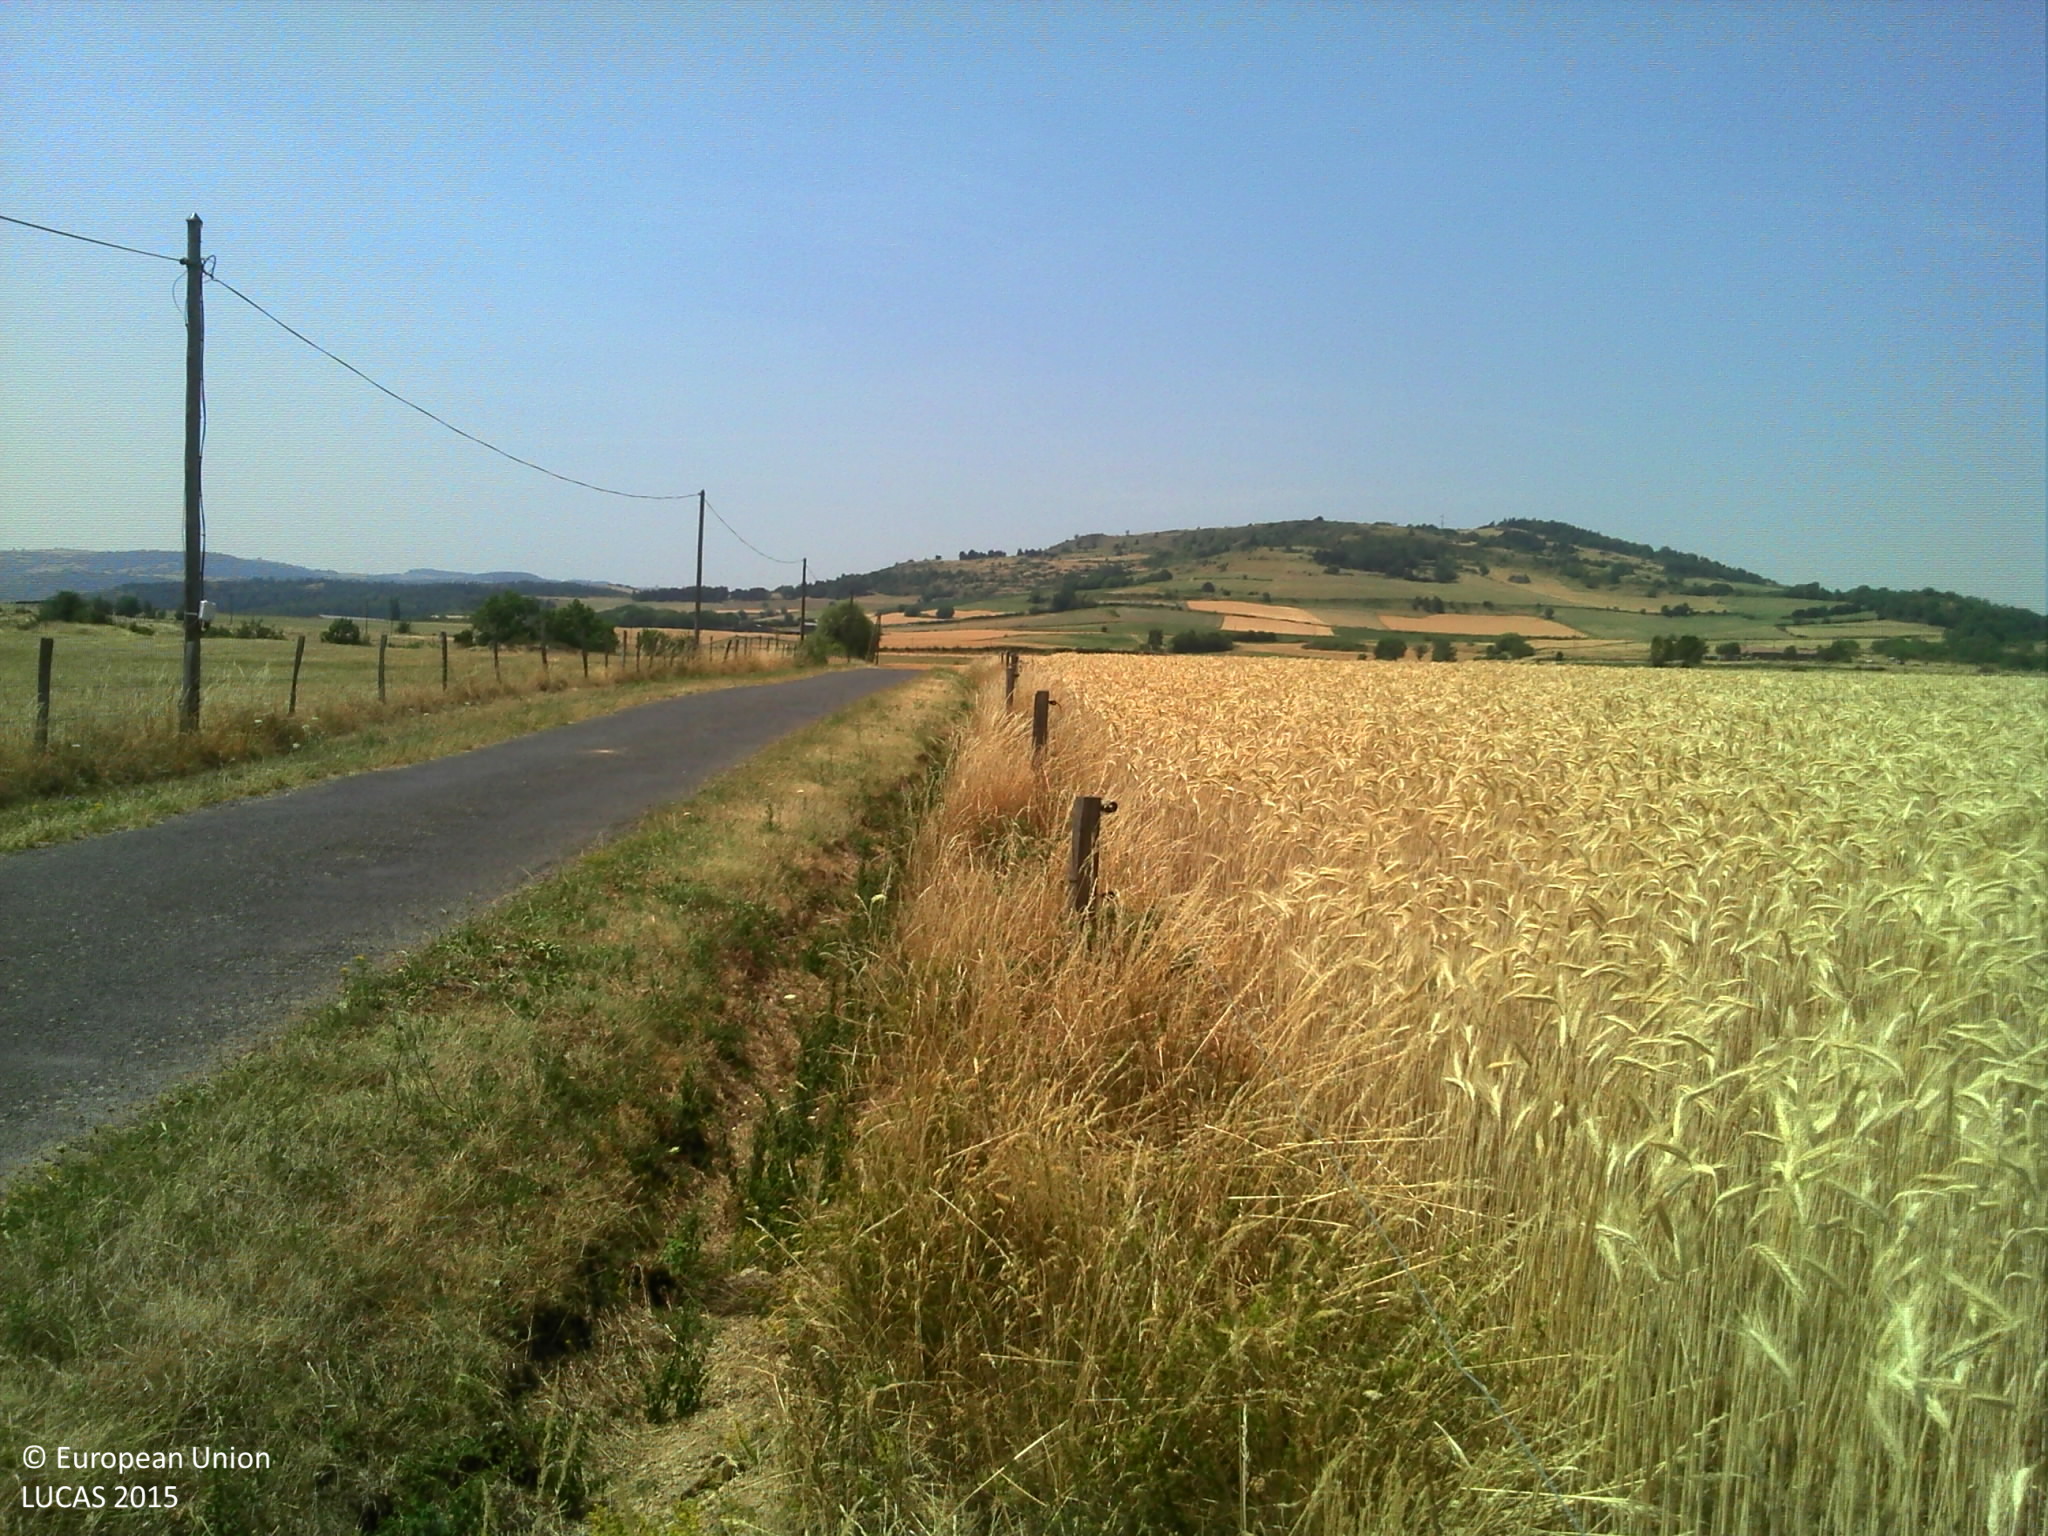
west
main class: Cropland
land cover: Rye
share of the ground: > 75 %
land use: Agriculture (excluding fallow land and kitchen gardens)
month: July
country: FR
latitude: 45.3360
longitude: 3.1489
